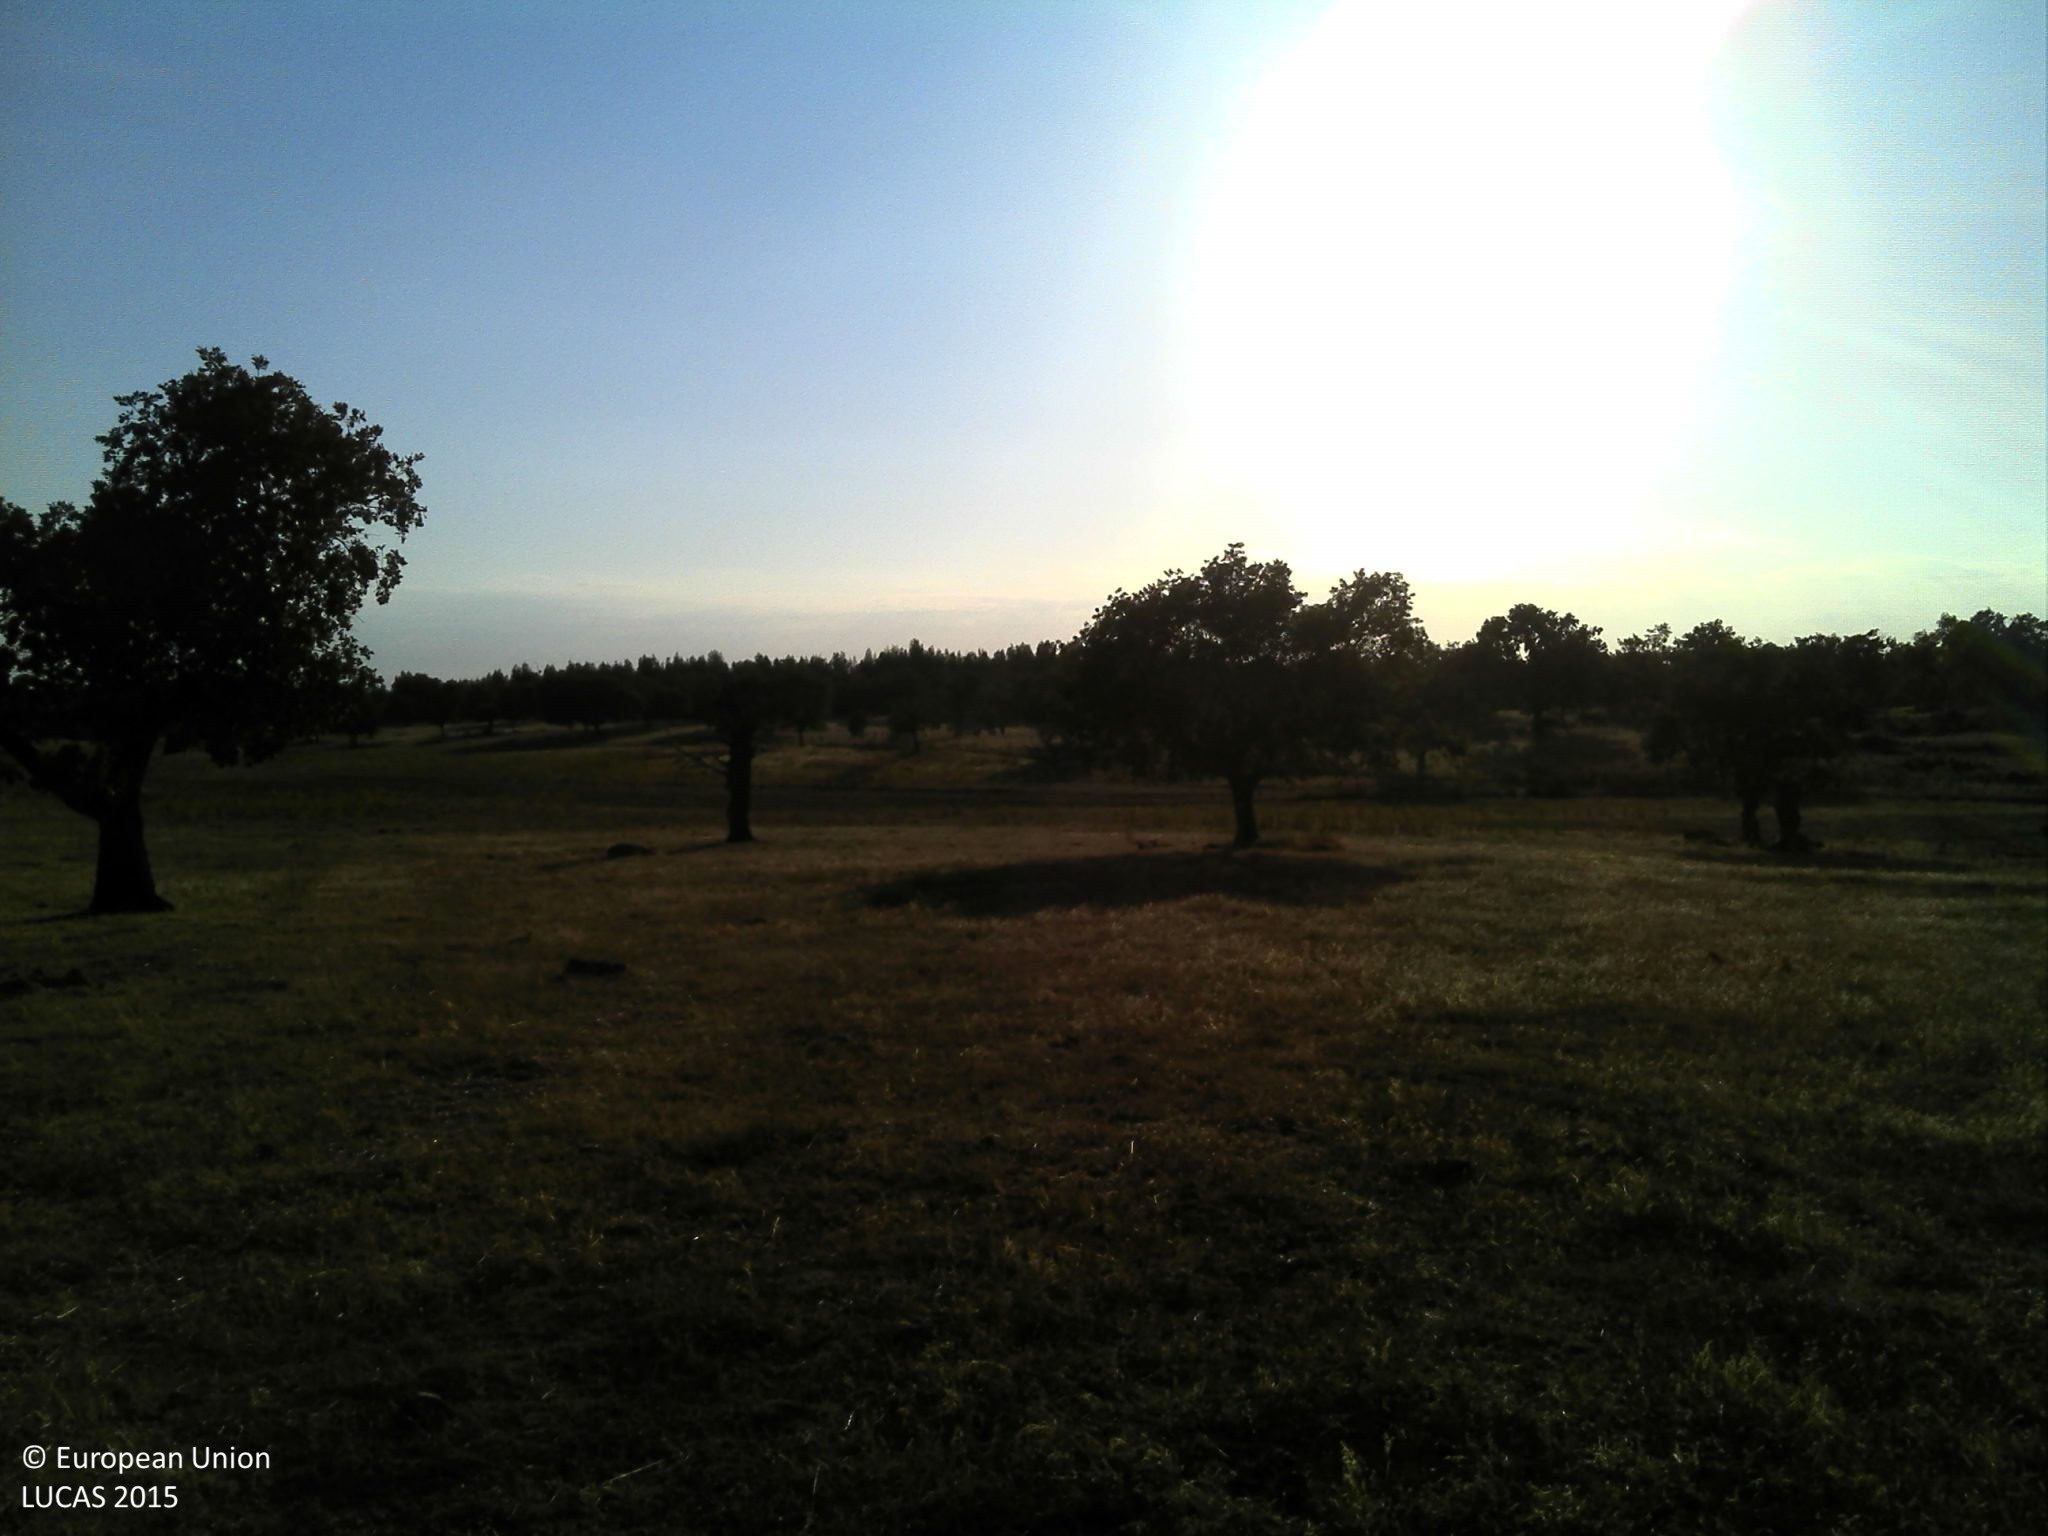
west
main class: Woodland
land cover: Broadleaved woodland
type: broadleaved evergreen forest
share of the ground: 10 - 25 %
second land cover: Grassland without tree/shrub cover
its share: 10 - 25 %
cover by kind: unconsolidated bare surface 80 %, broadleaved forest trees 10 %, herbaceous plants 10 %
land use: Forestry
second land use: Agriculture (excluding fallow land and kitchen gardens)
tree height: > 5 m
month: August
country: PT
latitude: 39.3533
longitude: -7.5569
